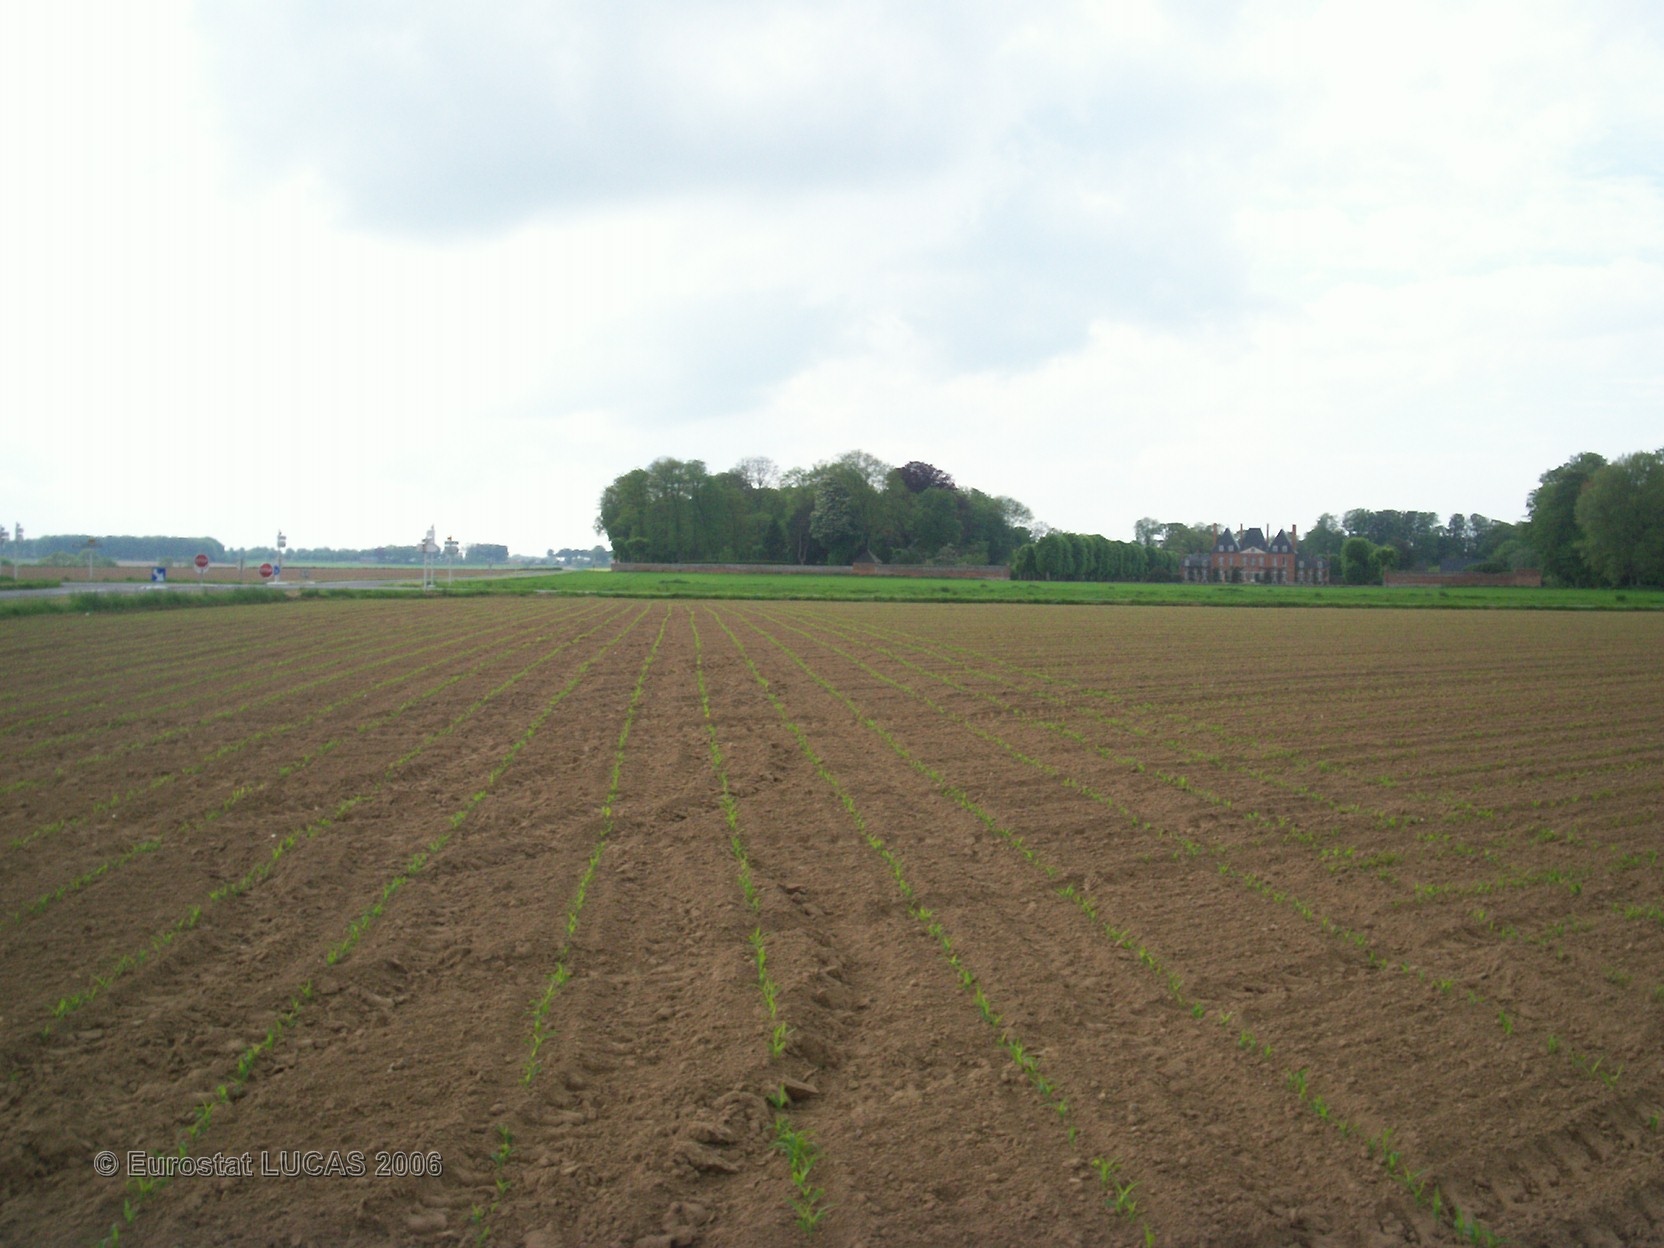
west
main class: Cropland
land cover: Maize
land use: Agriculture (excluding fallow land and kitchen gardens)
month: May
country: FR
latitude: 49.8108
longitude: 0.7900
